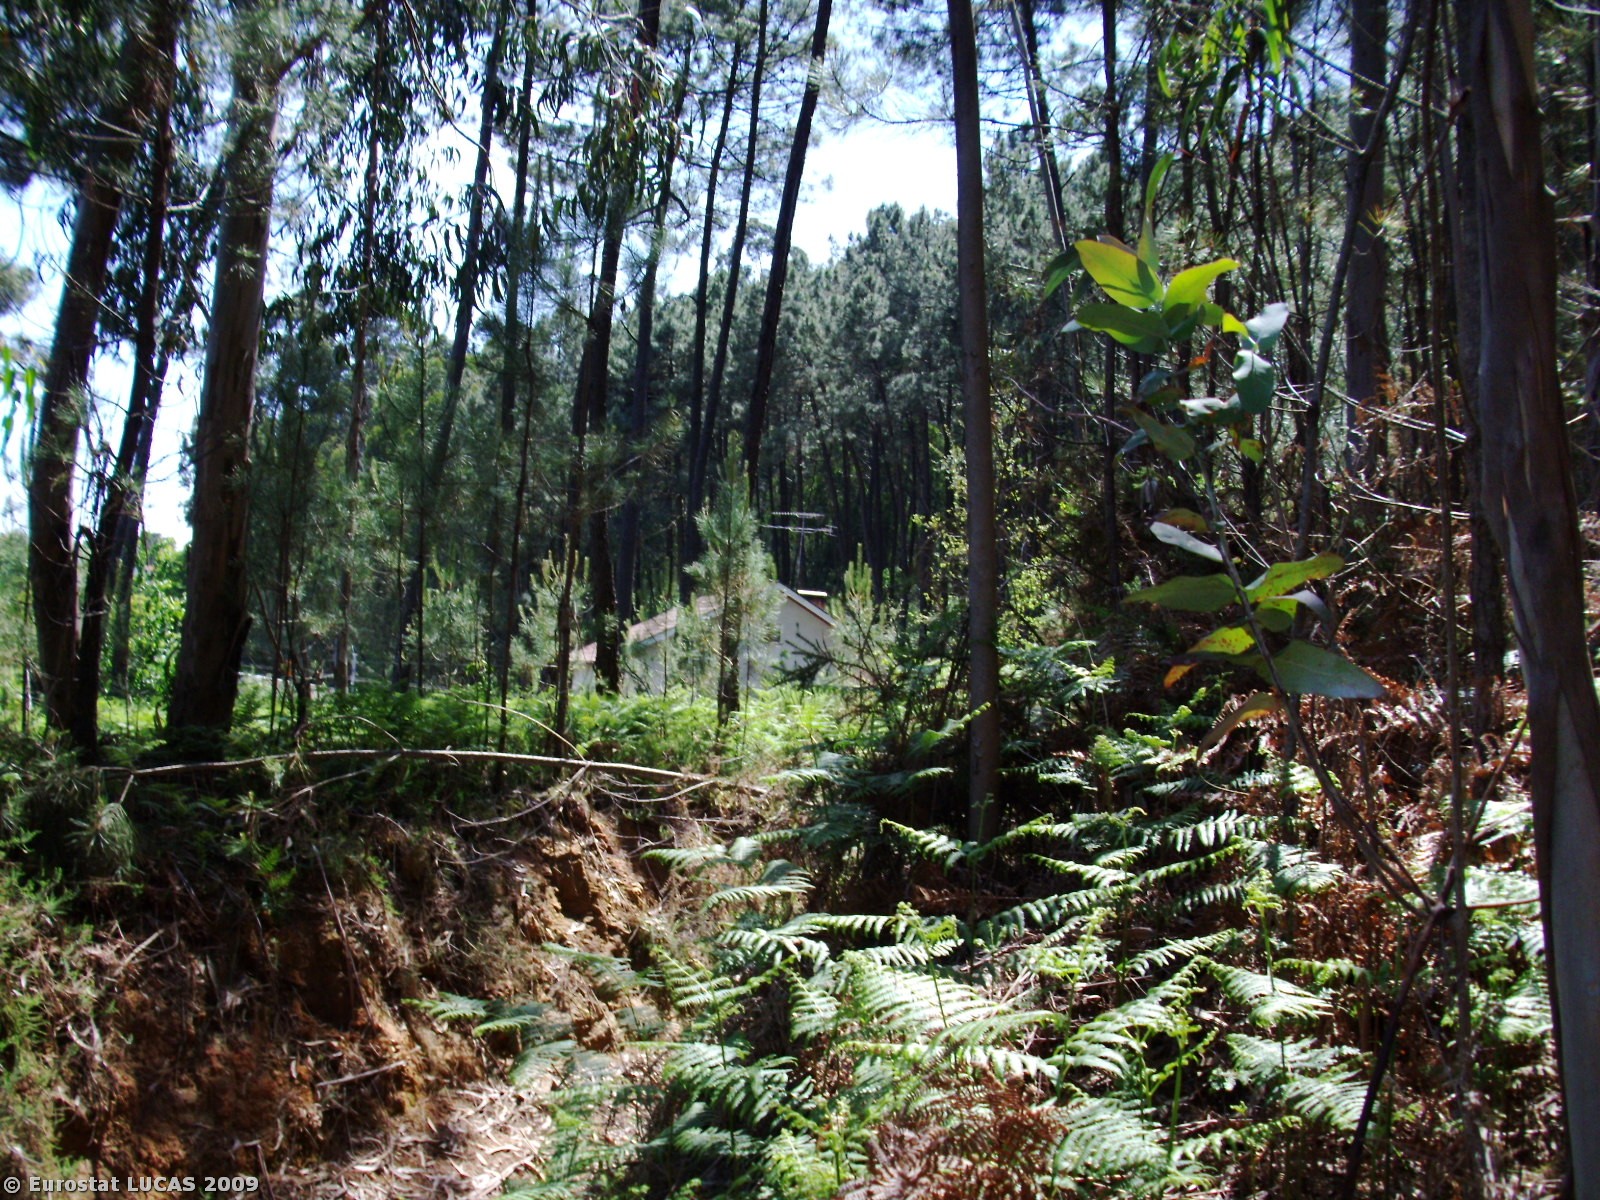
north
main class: Woodland
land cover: Broadleaved woodland
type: plantations and self-sown exotic forest
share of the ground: 50 - 75 %
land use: Forestry
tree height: > 5 m
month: May
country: PT
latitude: 41.6843
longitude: -8.6270
